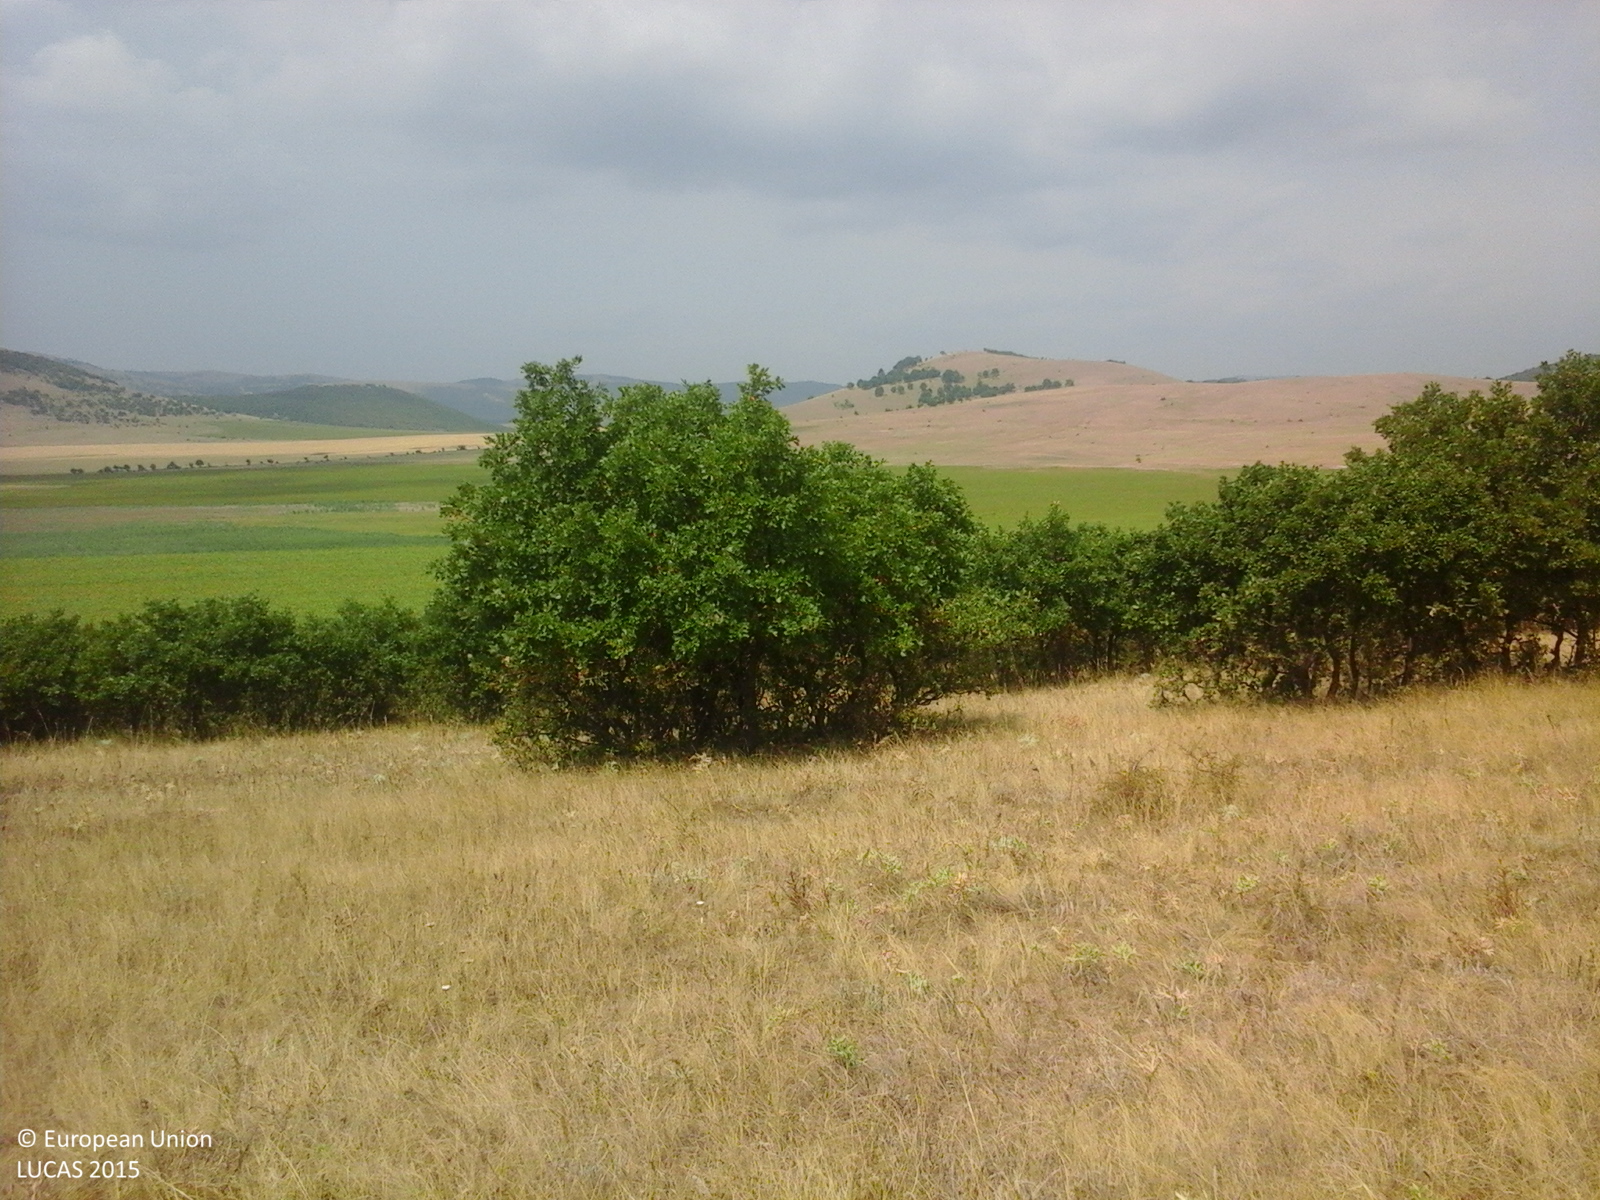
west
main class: Grassland
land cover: Grassland with sparse tree/shrub cover
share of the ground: > 75 %
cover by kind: herbaceous plants 85 %, shrubs 10 %, broadleaved forest trees 5 %
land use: Agriculture (excluding fallow land and kitchen gardens)
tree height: < 5 m
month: July
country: RO
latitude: 45.0594
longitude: 28.5576
